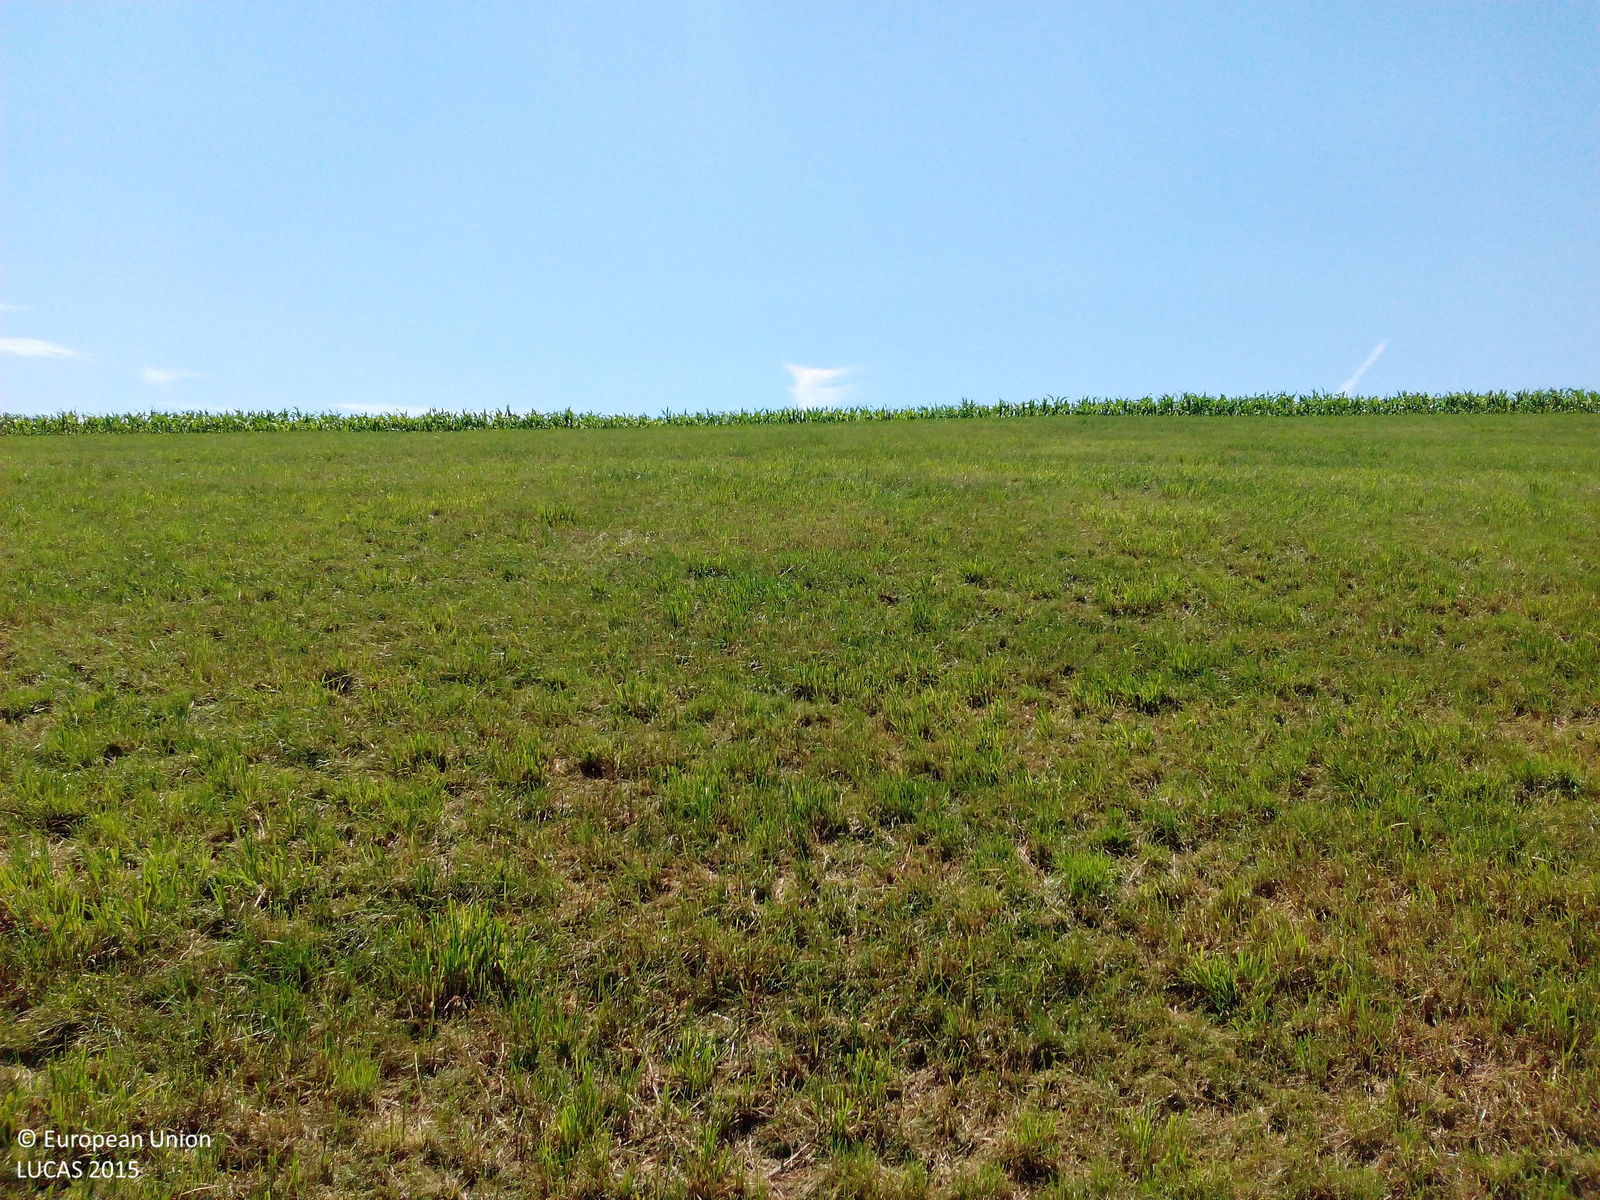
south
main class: Grassland
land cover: Grassland without tree/shrub cover
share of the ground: > 75 %
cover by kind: herbaceous plants 100 %
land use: Agriculture (excluding fallow land and kitchen gardens)
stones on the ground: < 10 %
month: July
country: DE
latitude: 51.7123
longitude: 9.8408
